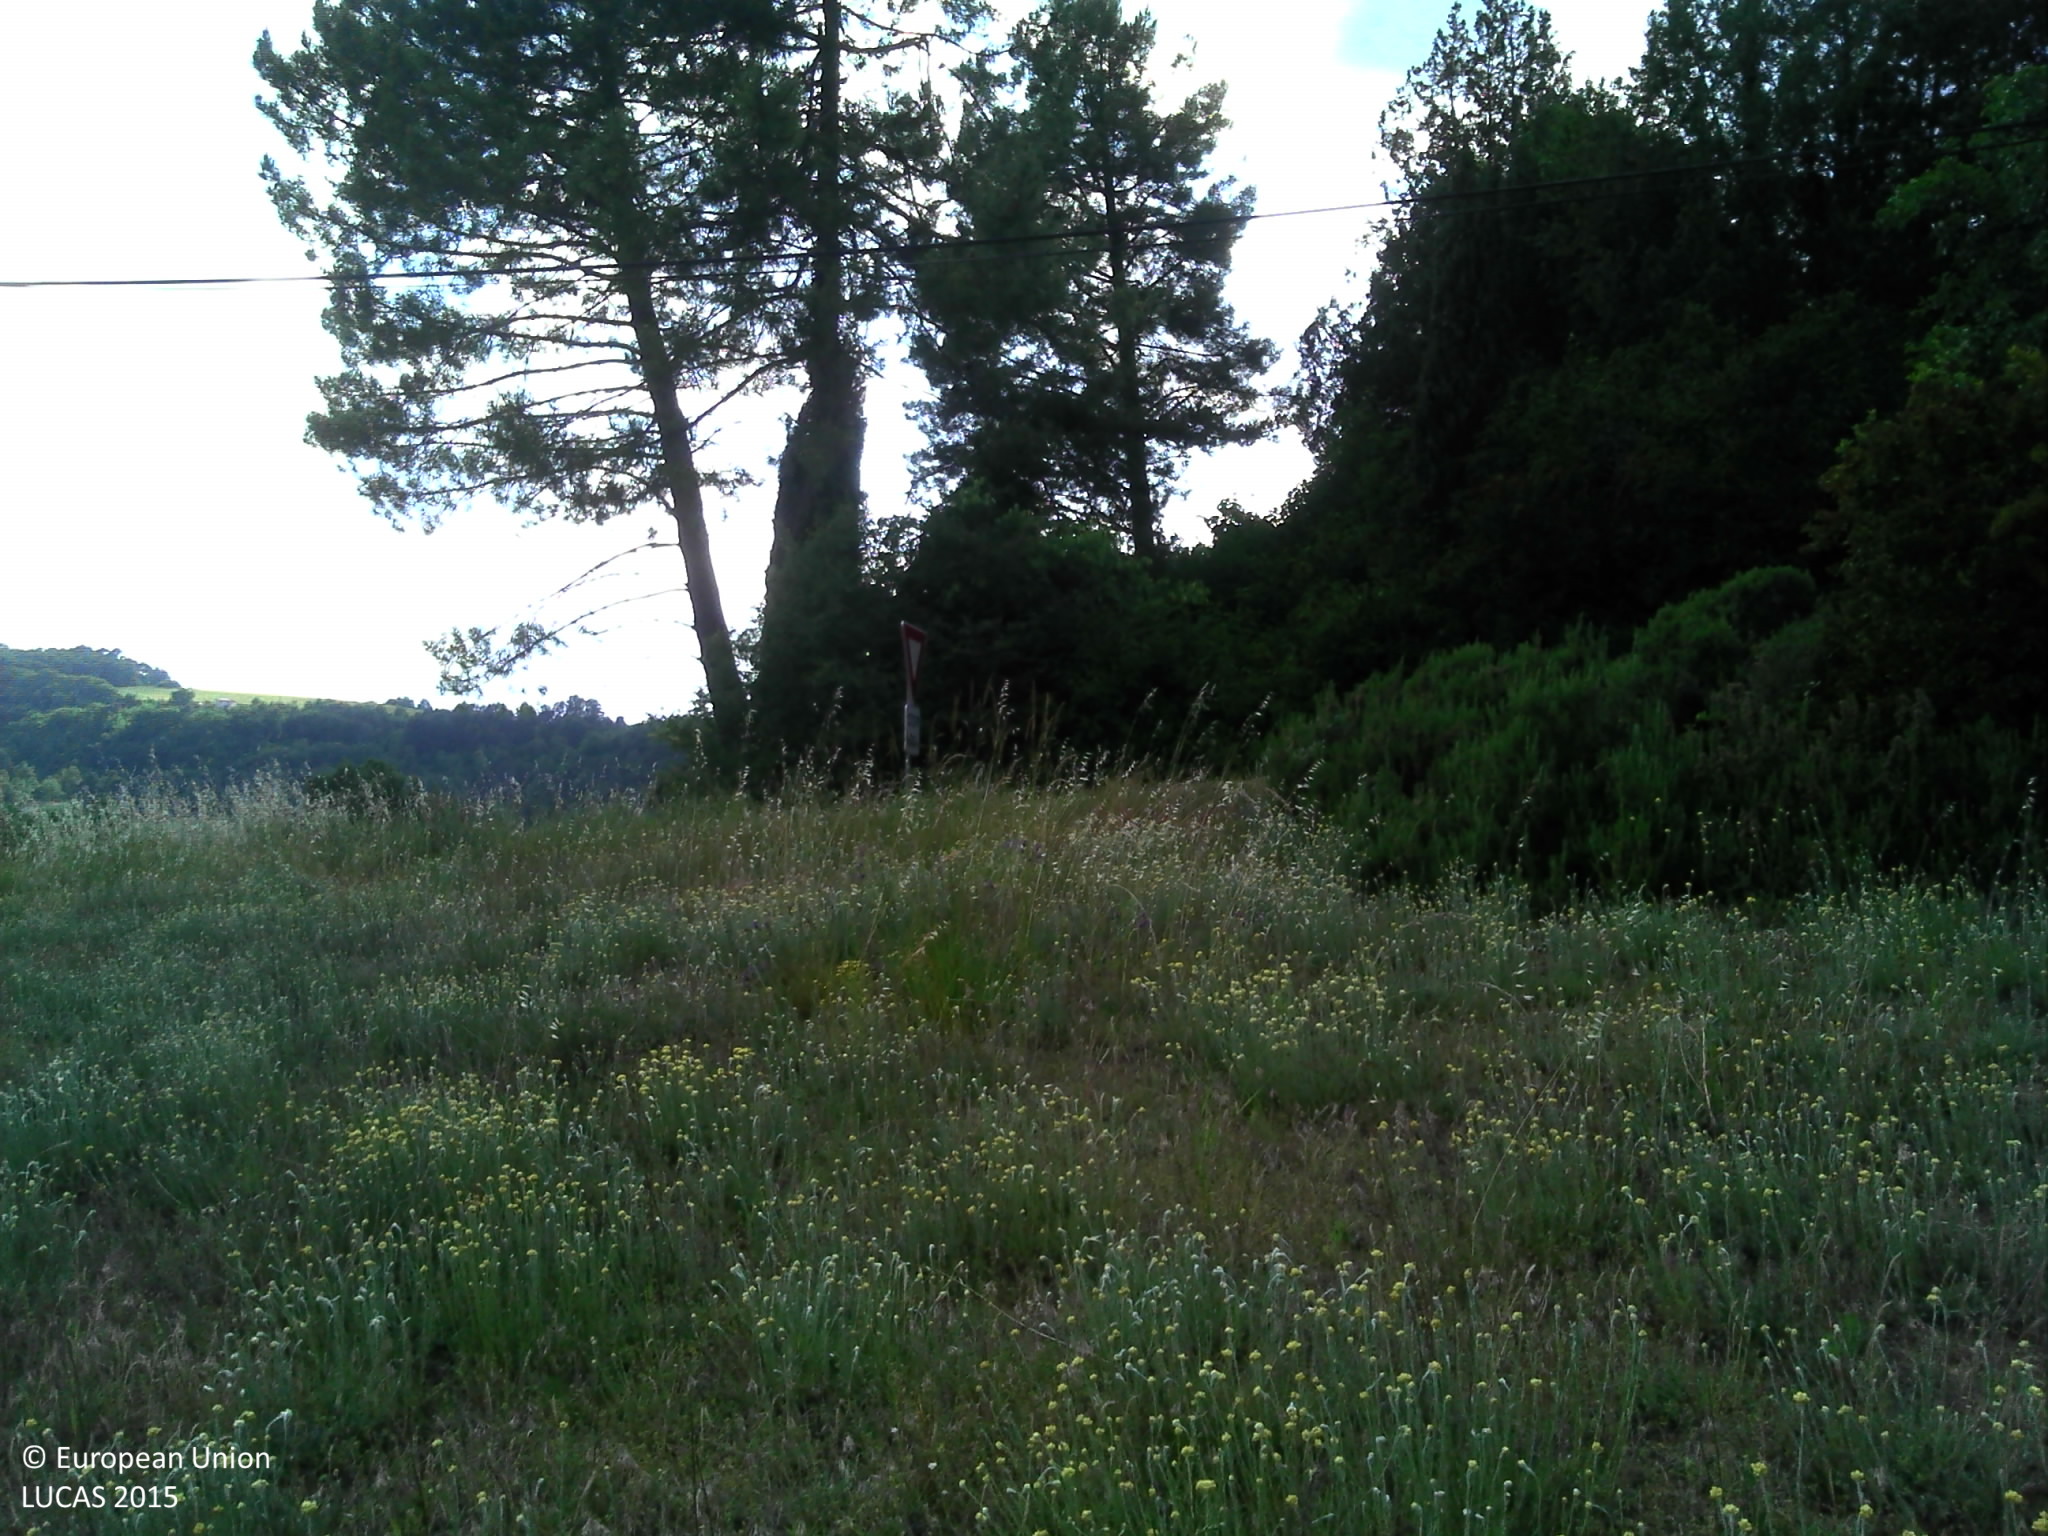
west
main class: Grassland
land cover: Grassland without tree/shrub cover
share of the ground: > 75 %
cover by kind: herbaceous plants 100 %
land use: Agriculture (excluding fallow land and kitchen gardens)
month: May
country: FR
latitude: 45.0988
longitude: 5.0367
